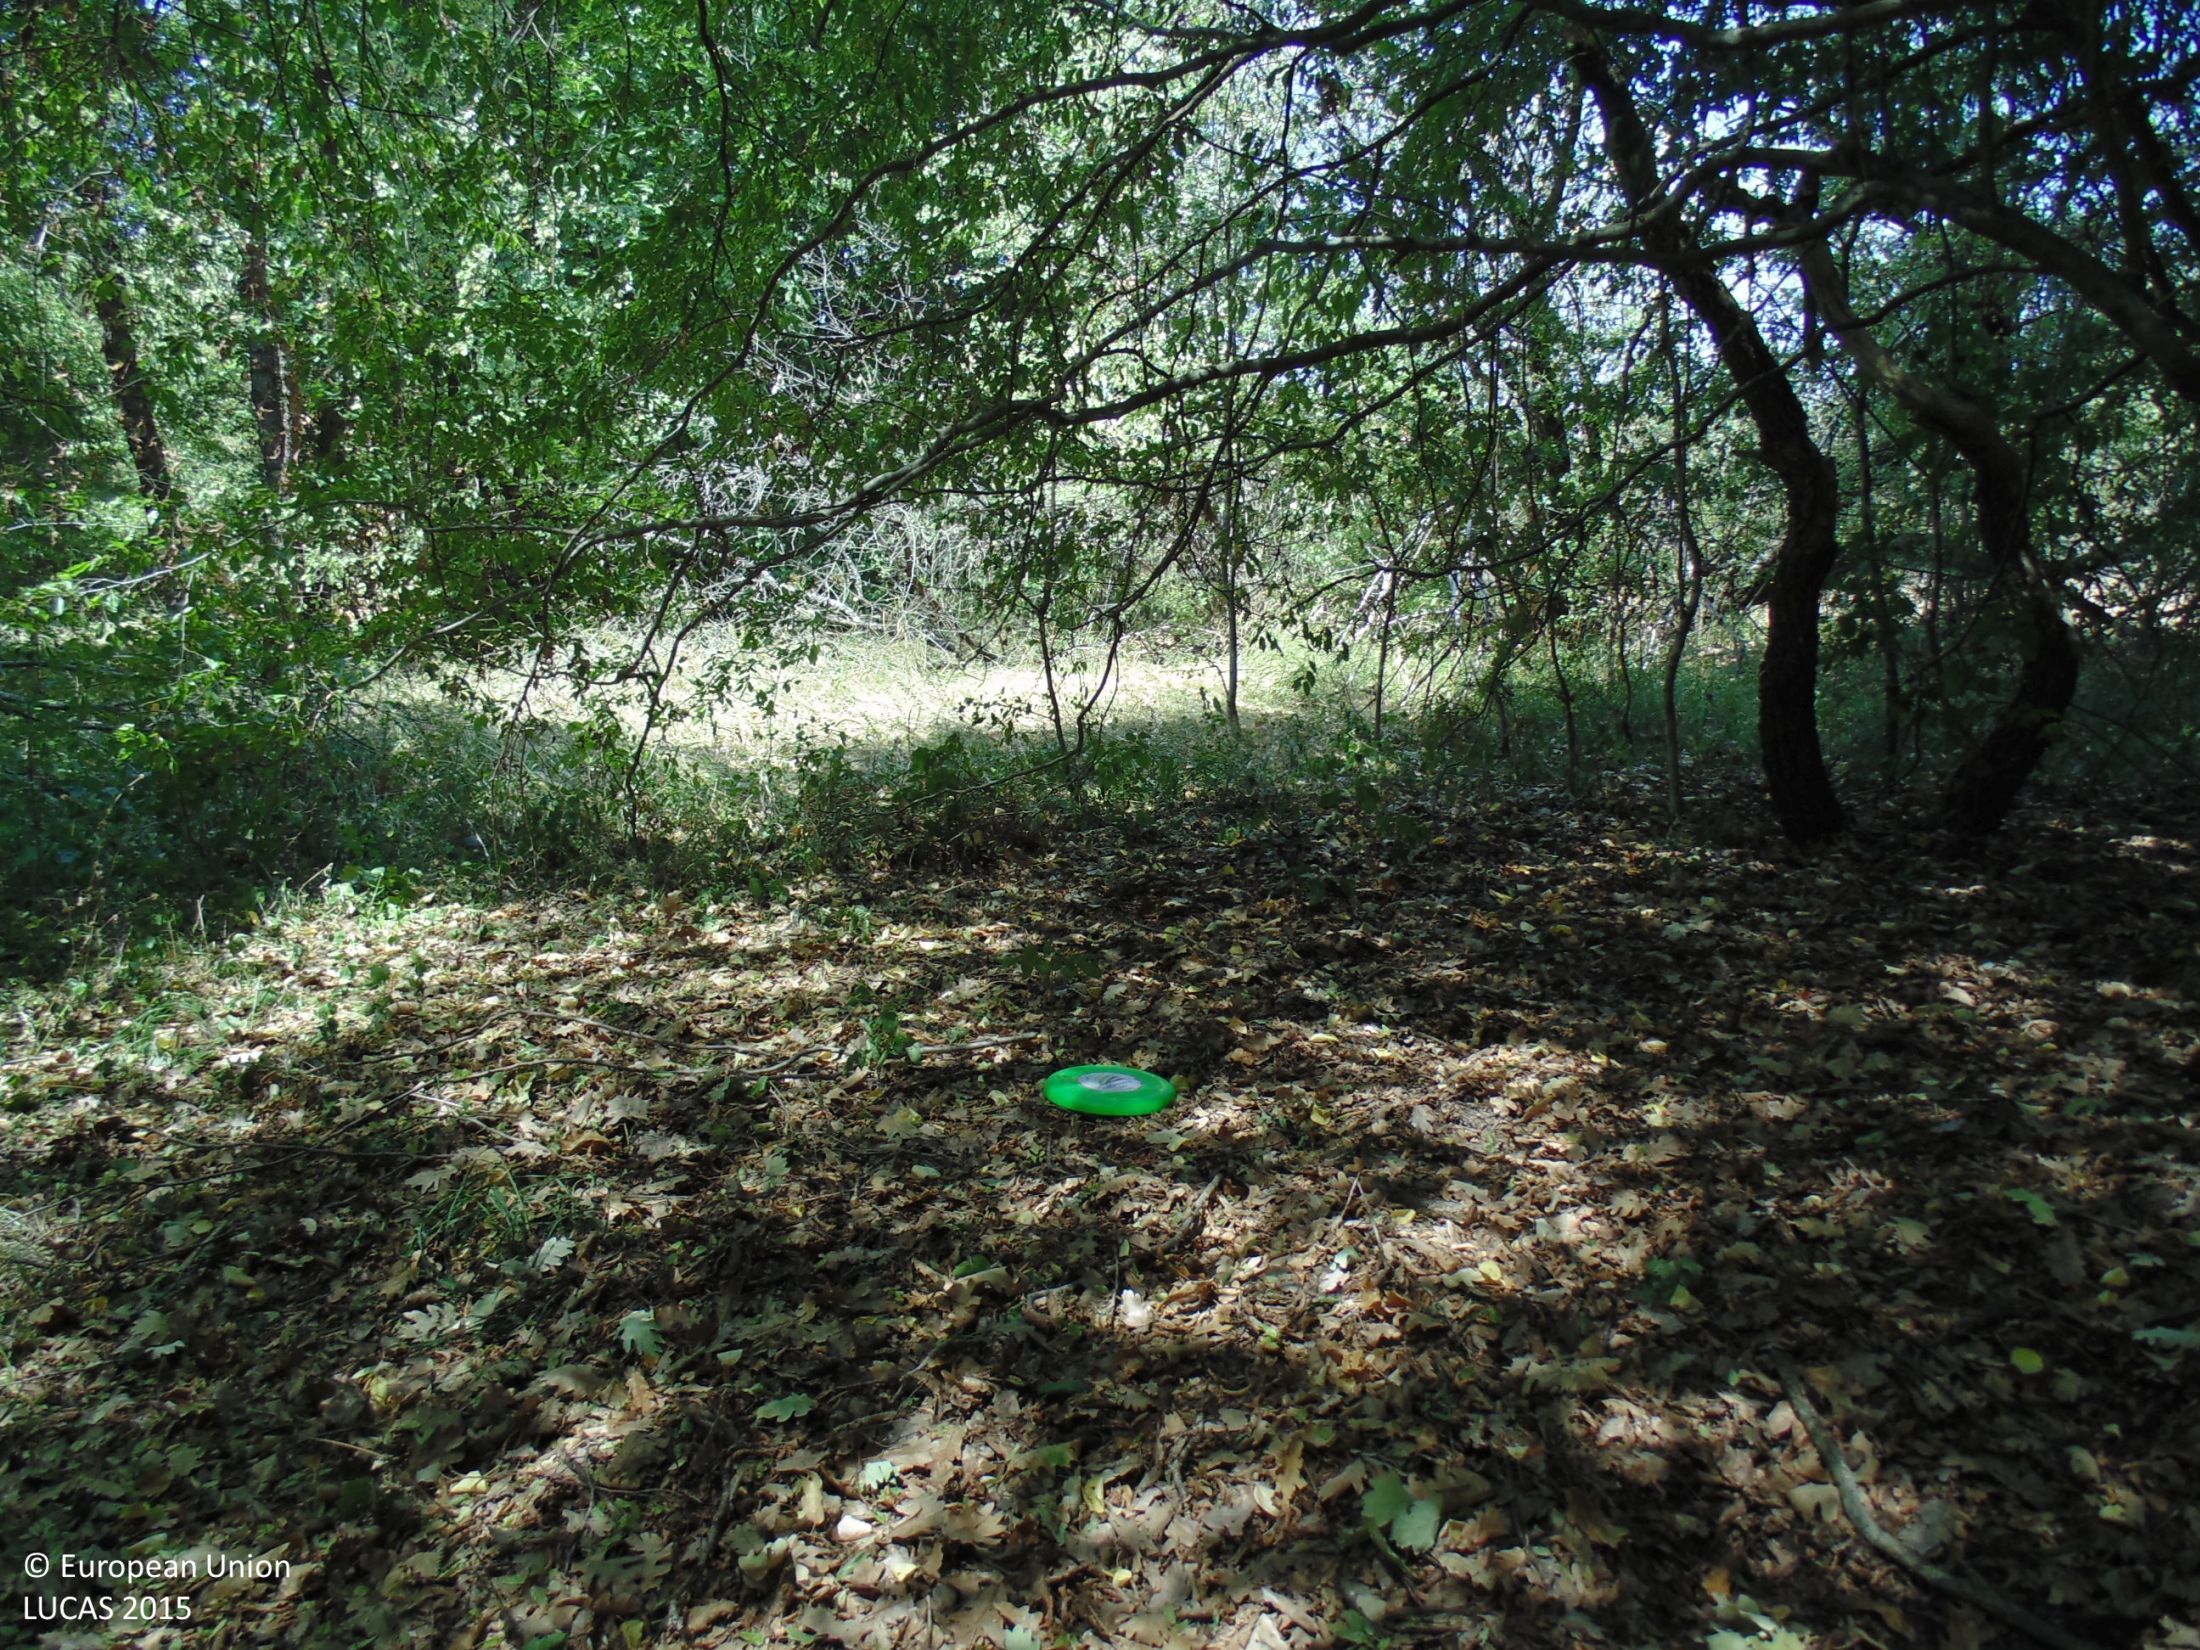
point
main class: Woodland
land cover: Broadleaved woodland
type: mesophytic deciduous forest
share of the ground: > 75 %
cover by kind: broadleaved forest trees 90 %, shrubs 5 %, unconsolidated bare surface 5 %
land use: Forestry
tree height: > 5 m
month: August
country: BG
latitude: 43.7204
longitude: 27.5758
